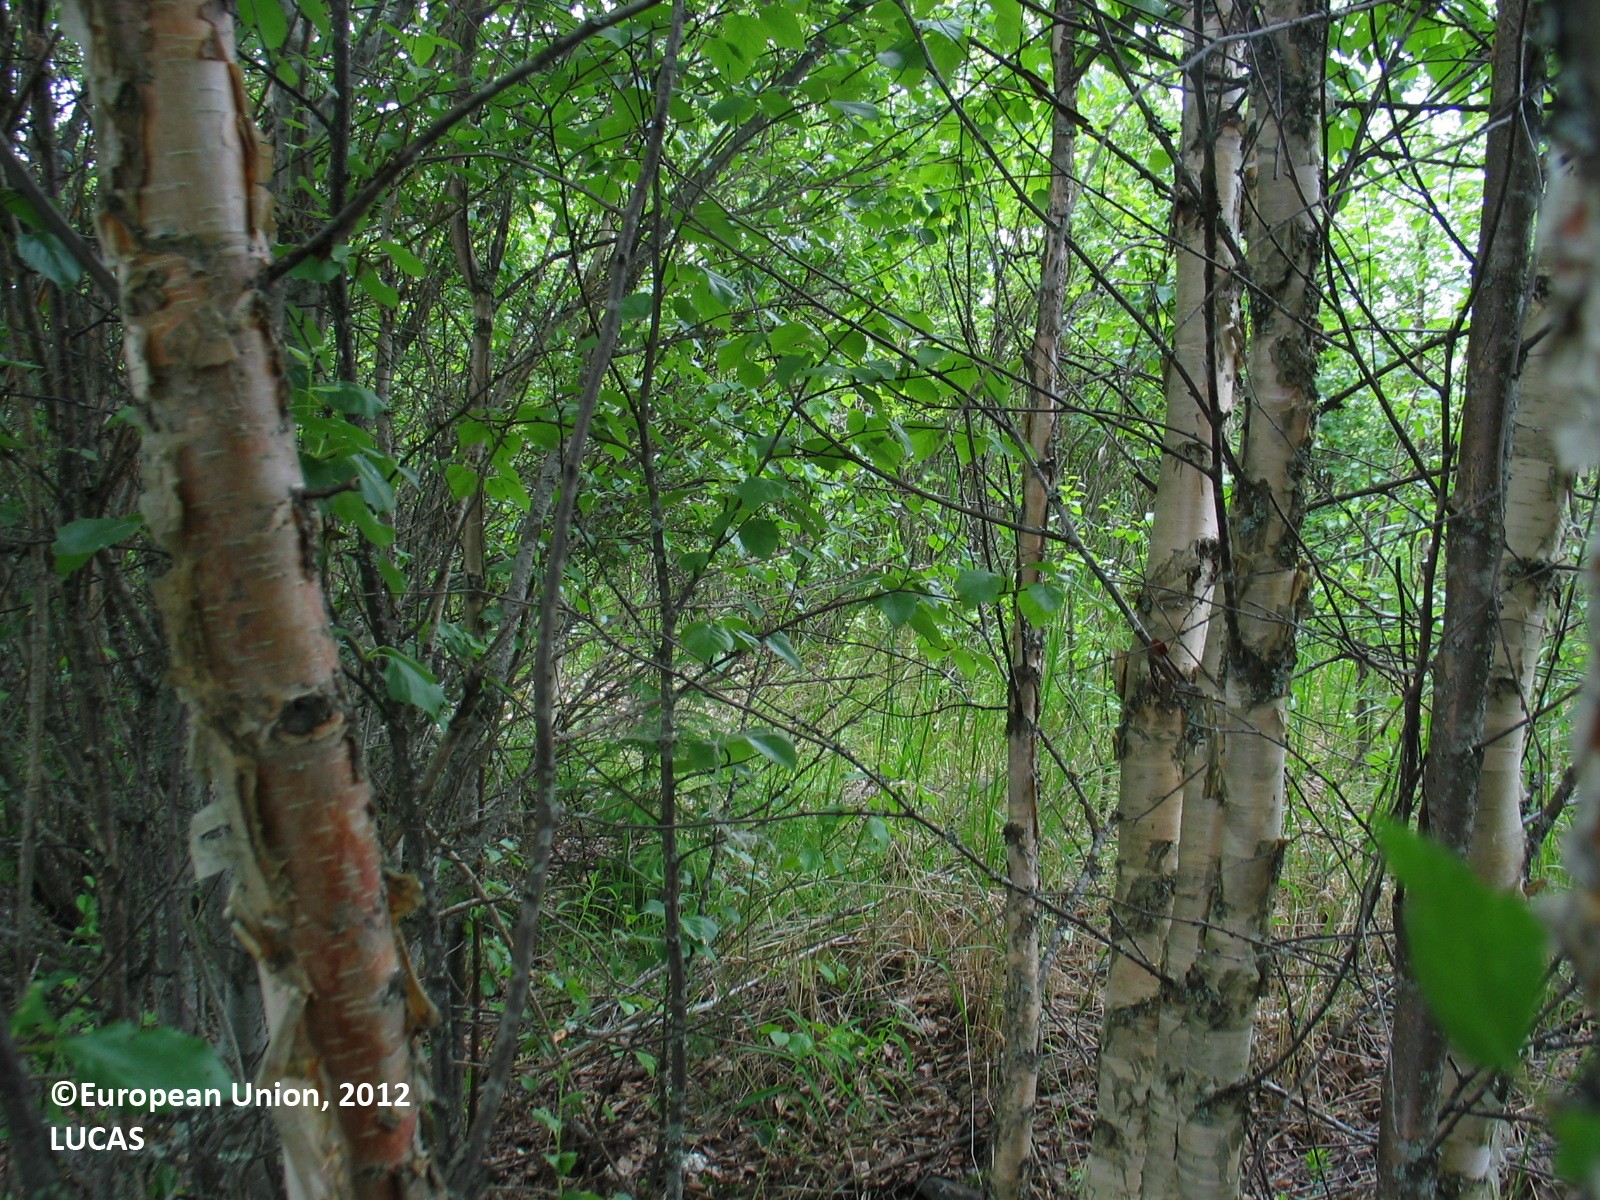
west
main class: Woodland
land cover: Pine dominated coniferous woodland
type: mire and swamp forests
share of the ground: 10 - 25 %
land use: Semi-natural and natural areas not in use
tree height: > 5 m
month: June
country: FI
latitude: 64.8172
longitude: 26.5622
